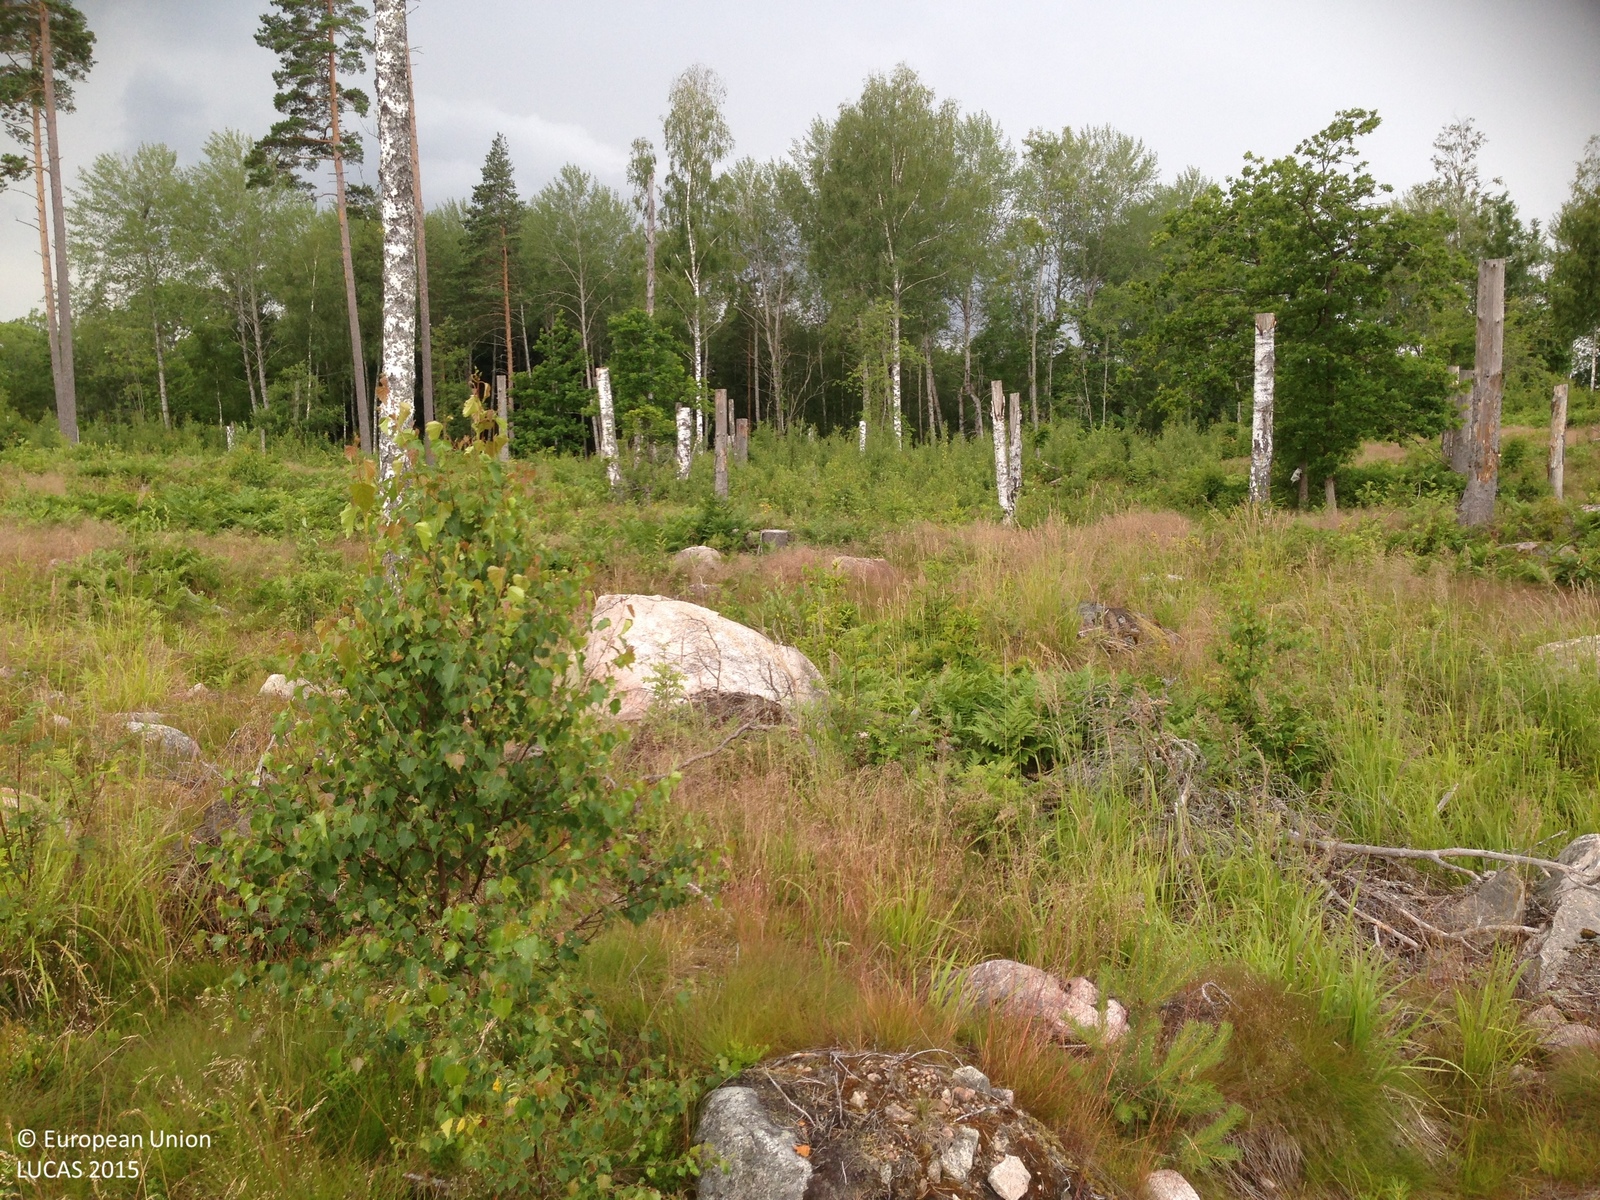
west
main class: Woodland
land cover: Broadleaved woodland
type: boreal forest
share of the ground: 10 - 25 %
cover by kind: herbaceous plants 80 %, broadleaved forest trees 15 %, coniferous forest trees 5 %
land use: Forestry
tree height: < 5 m
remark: Clear cut
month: July
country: SE
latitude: 59.9669
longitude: 18.6863
